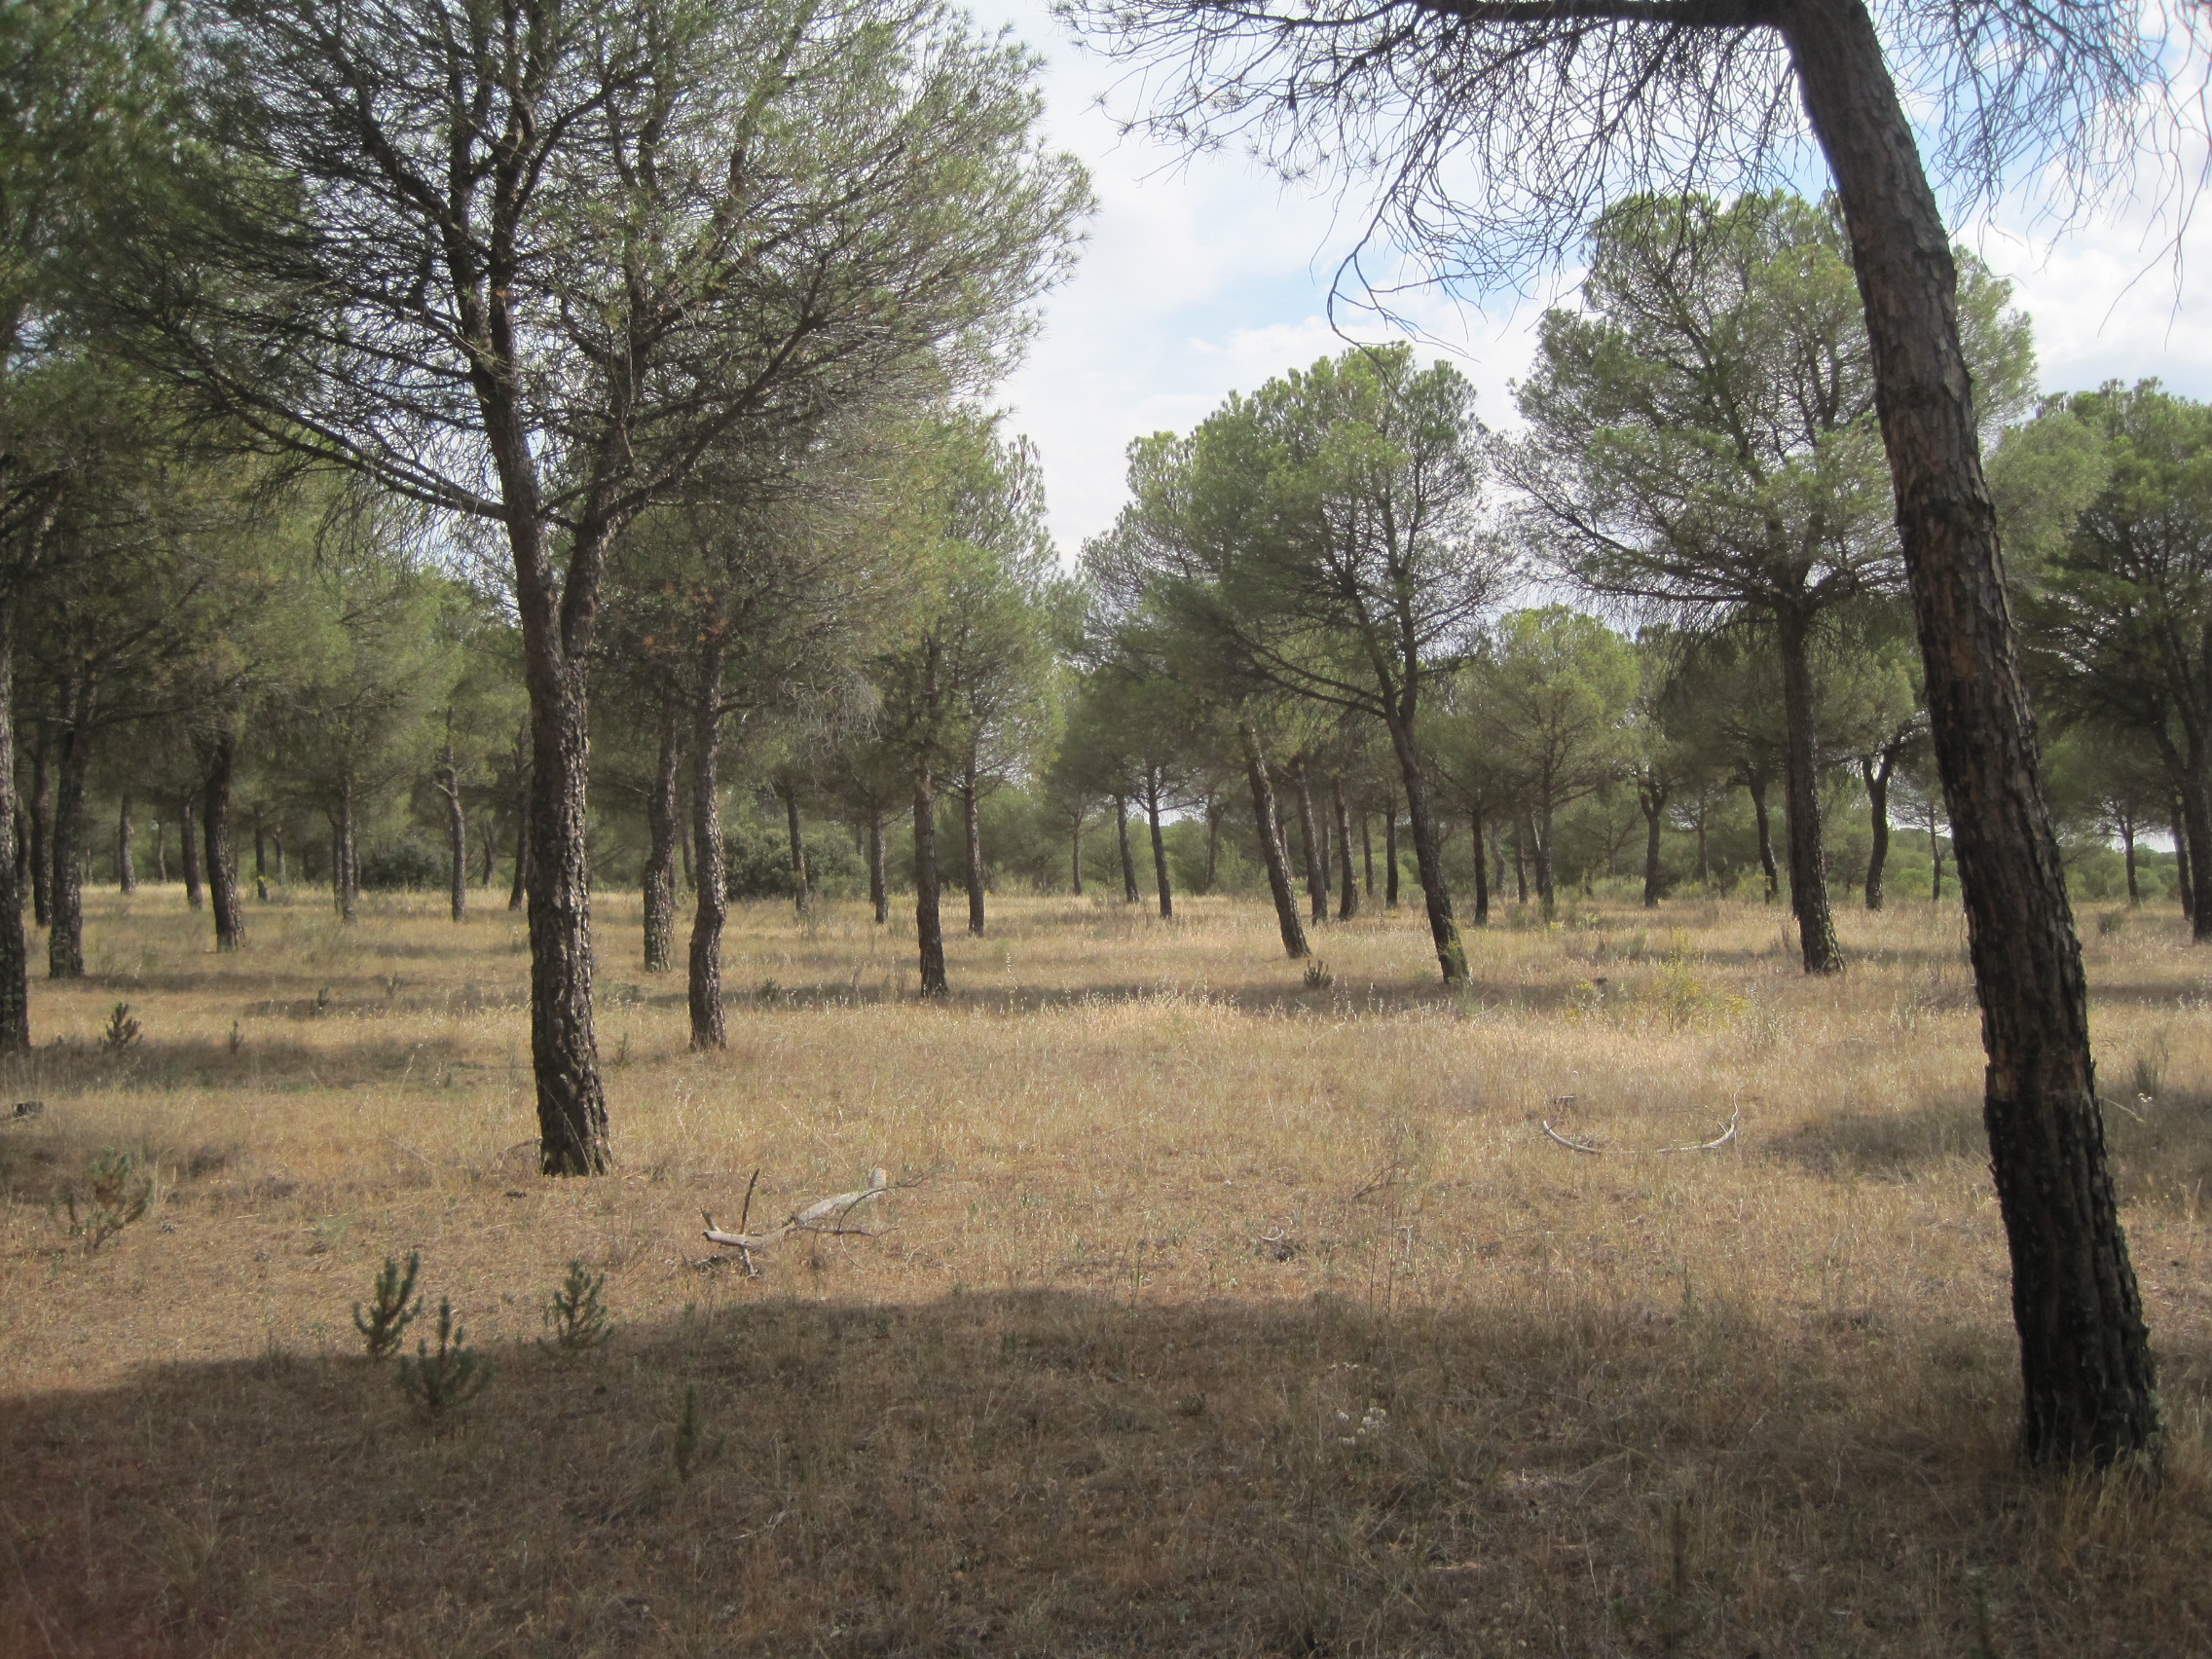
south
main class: Woodland
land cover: Pine dominated coniferous woodland
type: coniferous forest of the mediterranean region
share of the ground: 50 - 75 %
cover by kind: coniferous forest trees 70 %, herbaceous plants 30 %
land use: Forestry
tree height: > 5 m
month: June
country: ES
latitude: 41.4279
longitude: -5.0660
